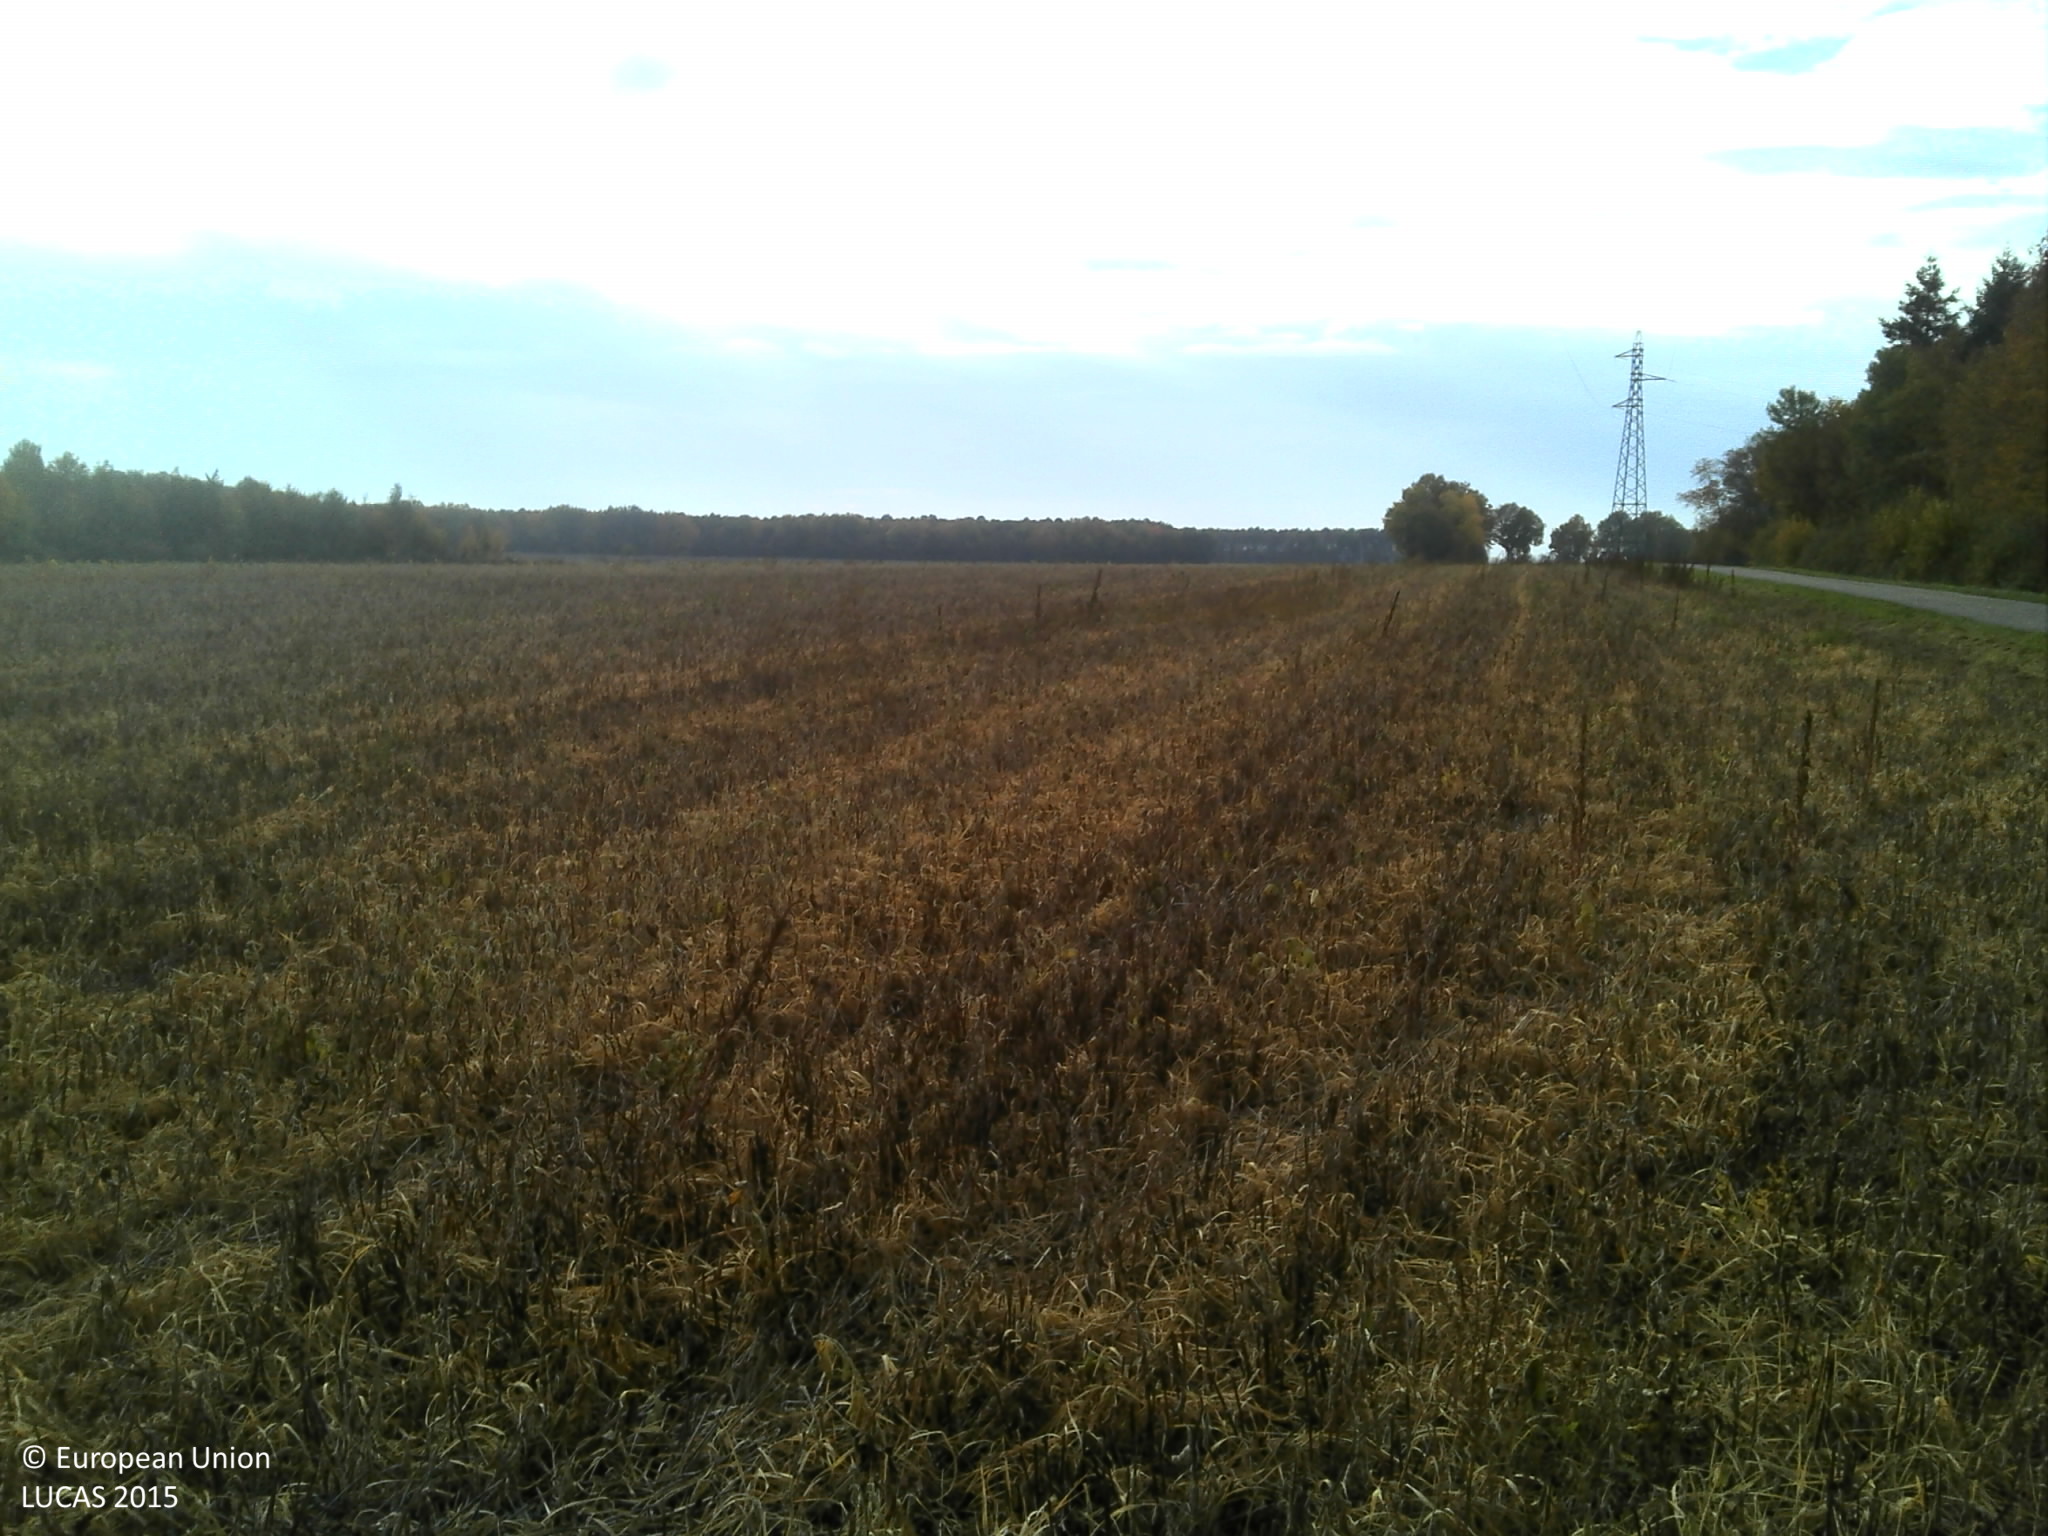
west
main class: Cropland
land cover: Common wheat
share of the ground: 50 - 75 %
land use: Agriculture (excluding fallow land and kitchen gardens)
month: October
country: FR
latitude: 47.0776
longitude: 5.2996
